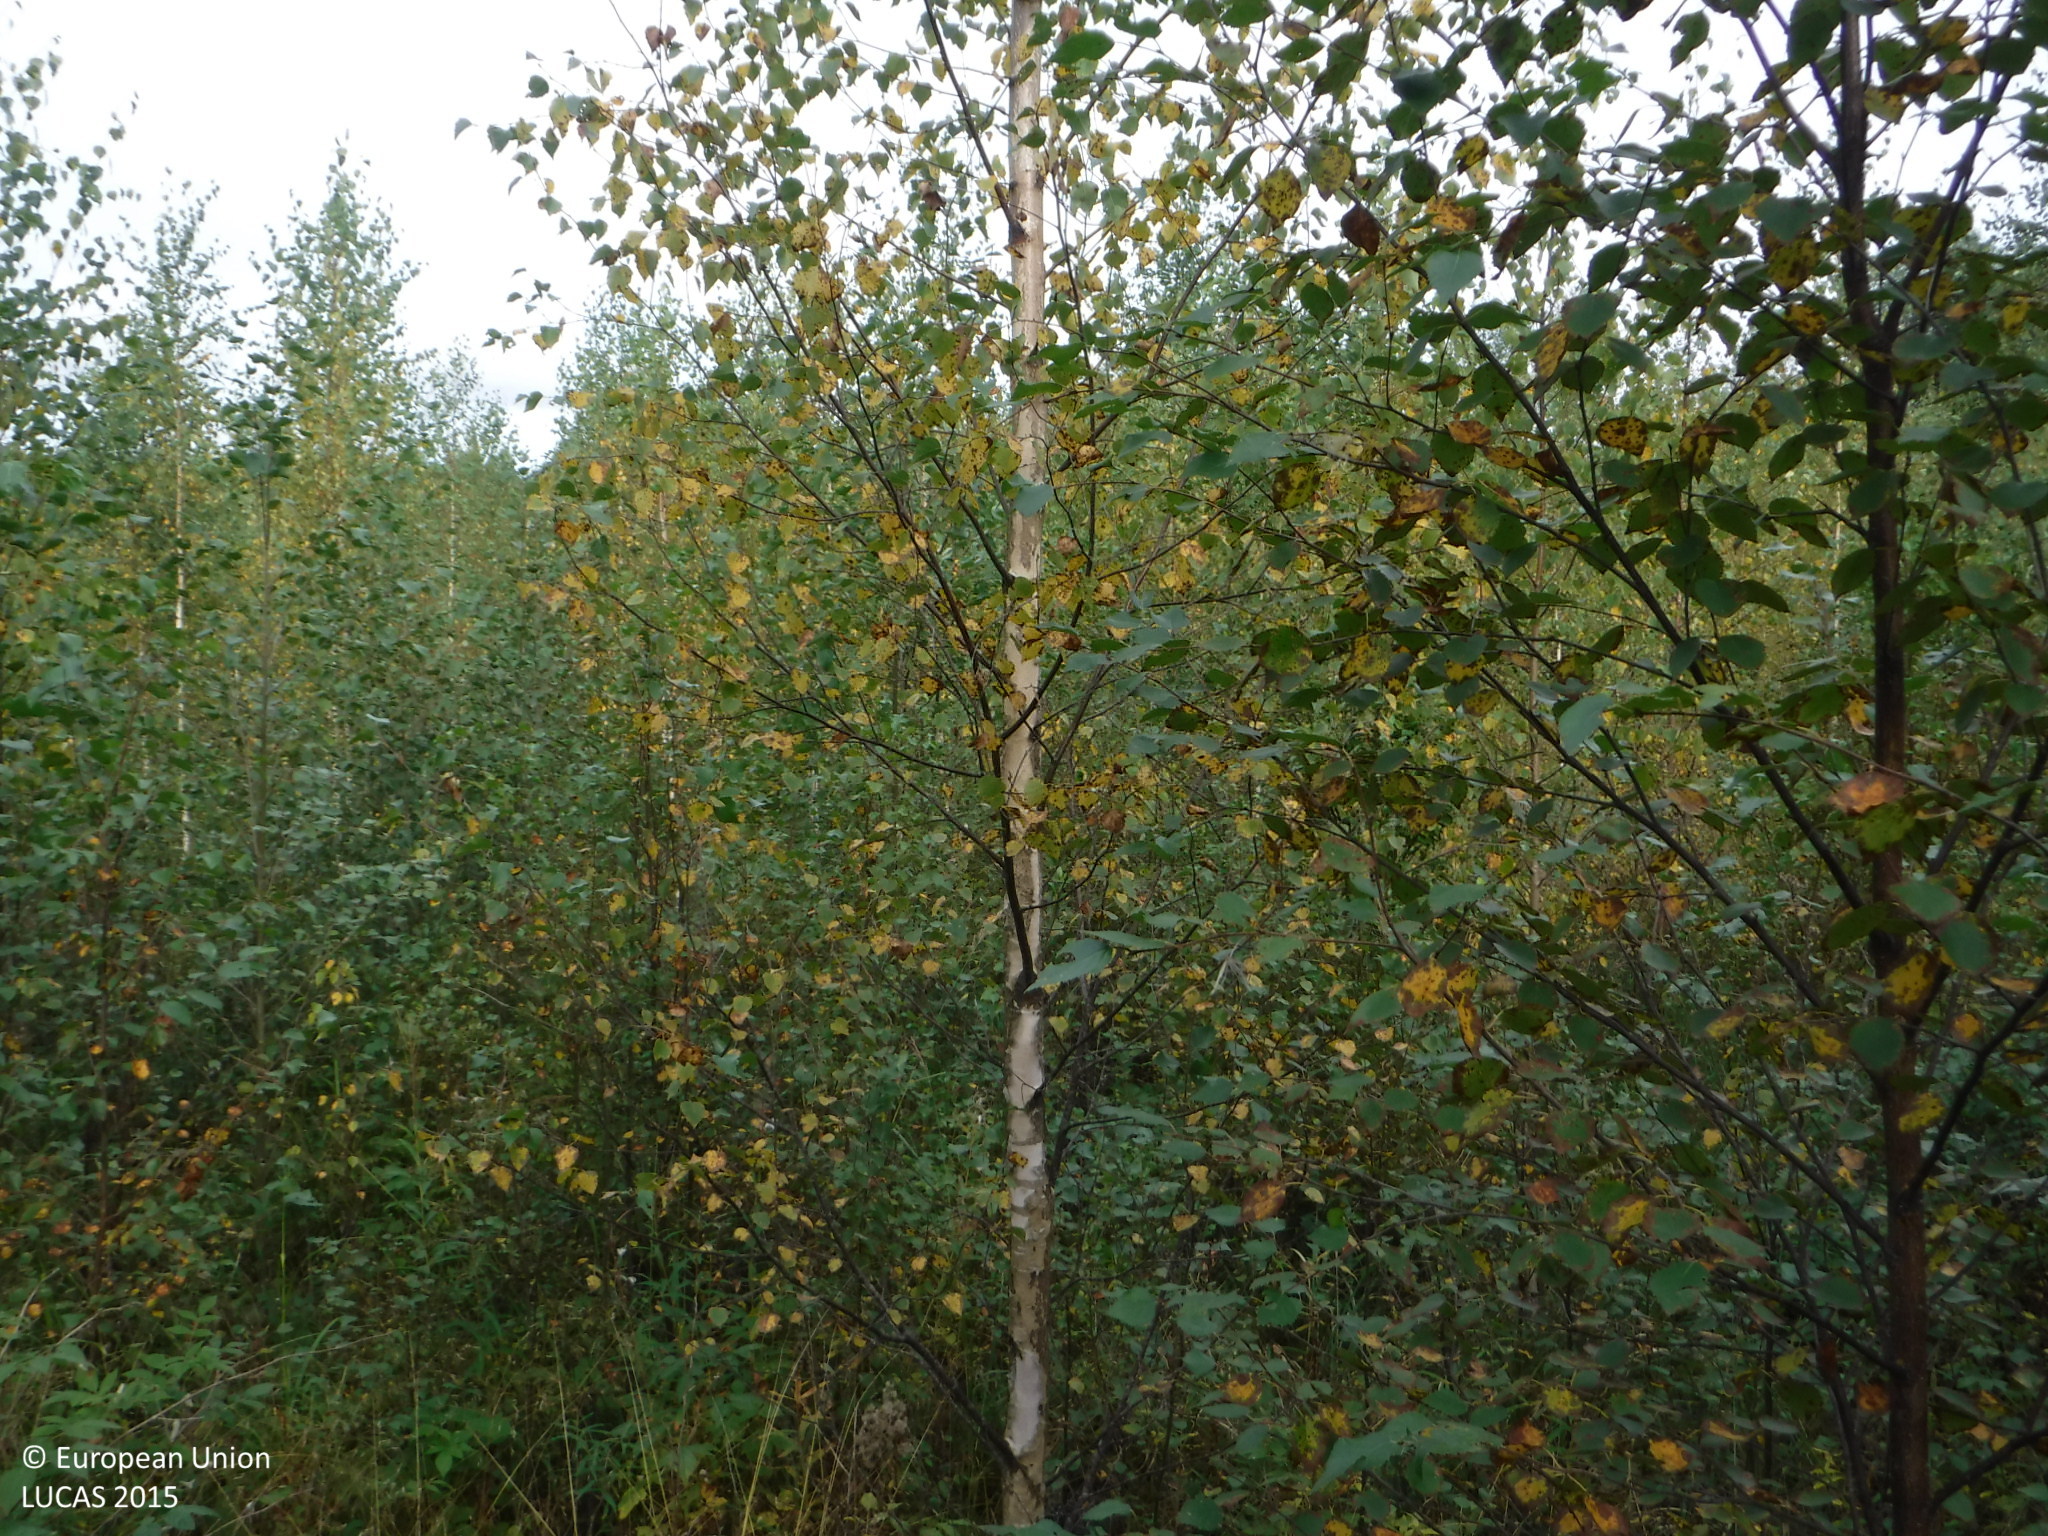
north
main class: Woodland
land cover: Broadleaved woodland
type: non-riverine alder, birch or aspen forest
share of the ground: 50 - 75 %
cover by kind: broadleaved forest trees 60 %, herbaceous plants 20 %, shrubs 10 %, lichens and mosses 10 %
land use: Forestry
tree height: < 5 m
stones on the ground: 25 - 50 %
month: September
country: FI
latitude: 61.3926
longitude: 22.9330
